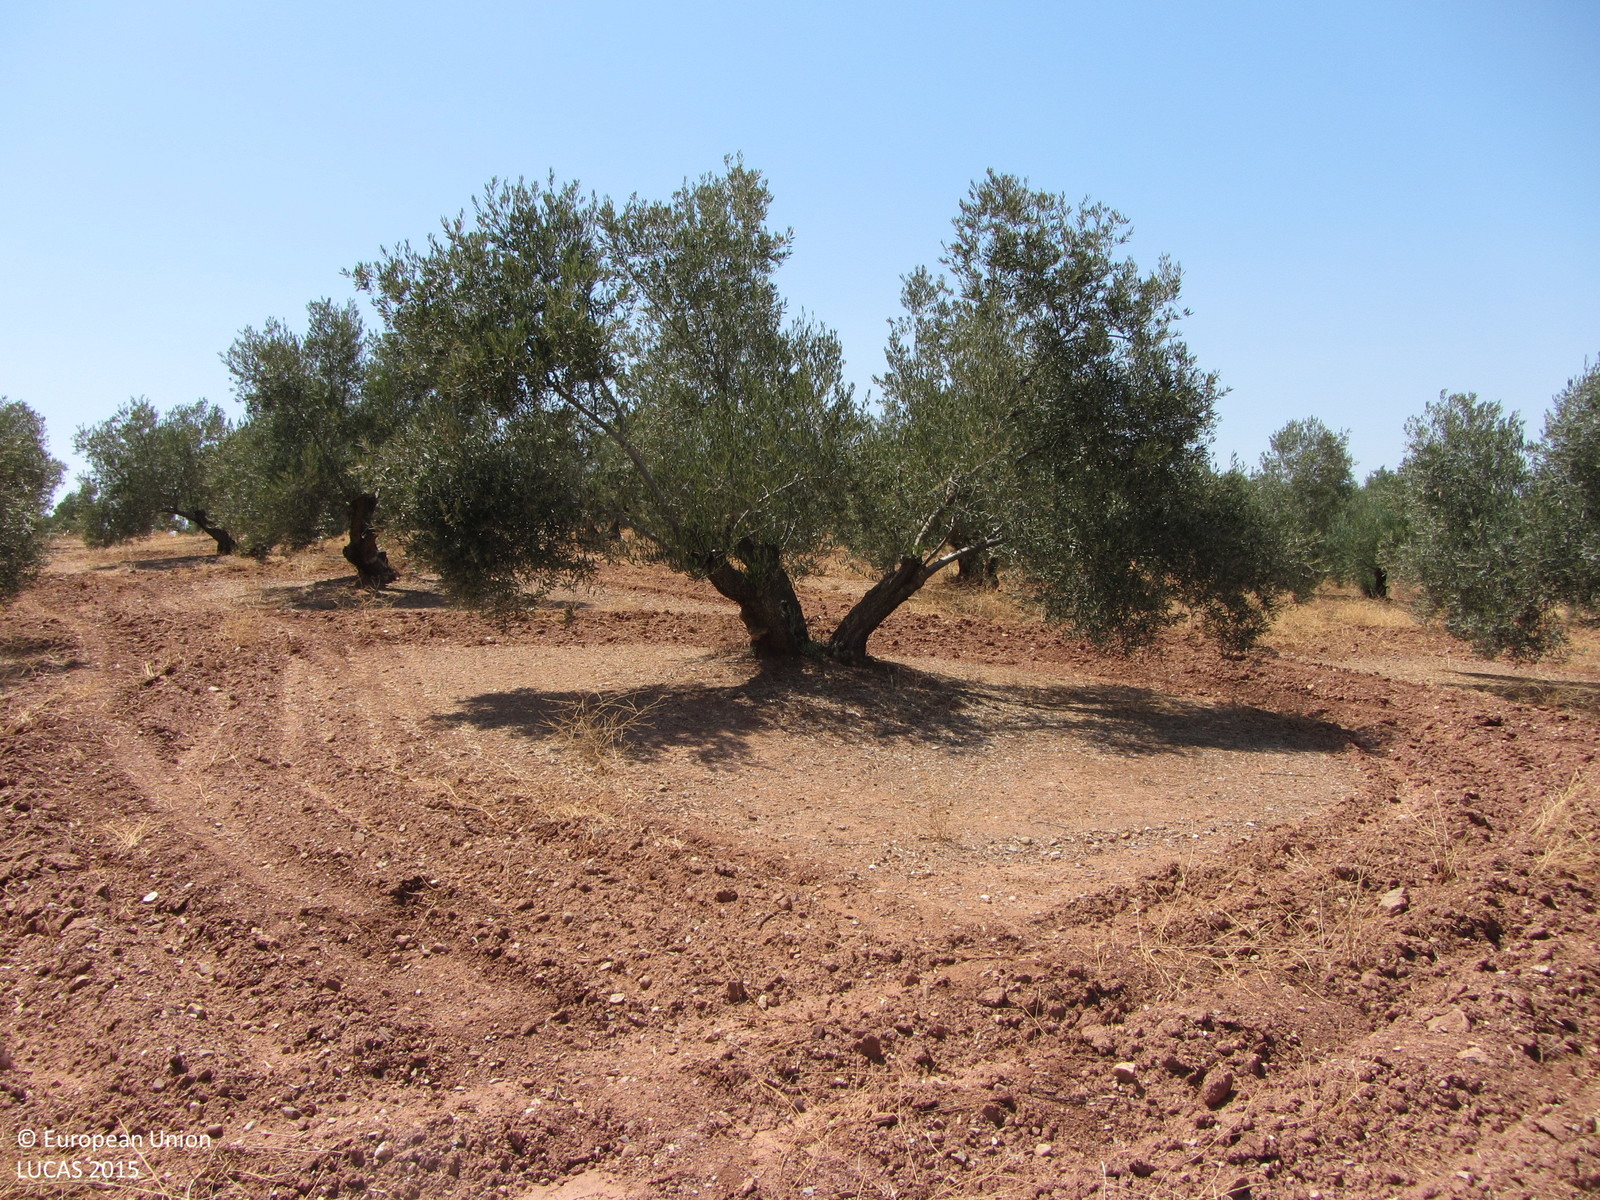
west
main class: Cropland
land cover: Olive groves
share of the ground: 25 - 50 %
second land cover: Other bare soil
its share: > 75 %
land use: Agriculture (excluding fallow land and kitchen gardens)
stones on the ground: 10 - 25 %
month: June
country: ES
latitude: 38.2367
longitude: -3.4512
